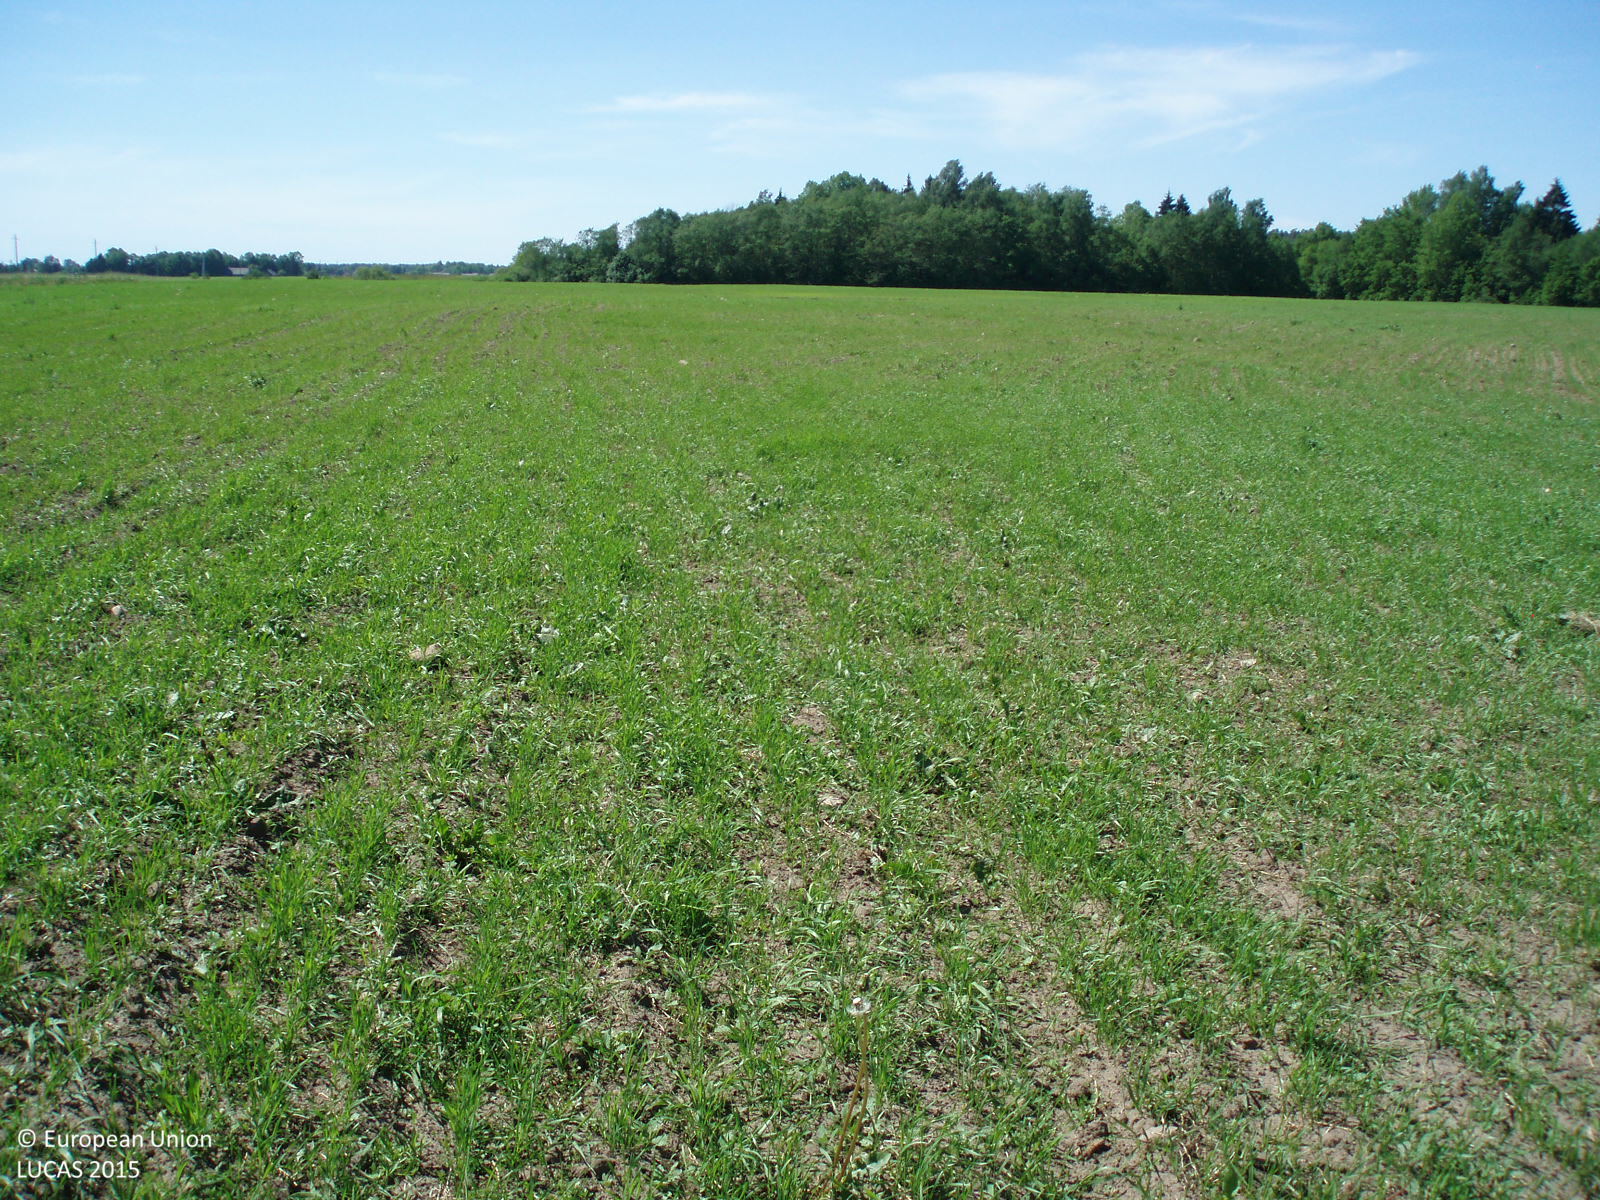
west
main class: Cropland
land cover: Rye
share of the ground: > 75 %
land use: Agriculture (excluding fallow land and kitchen gardens)
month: June
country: LT
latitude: 56.2206
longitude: 22.5904
